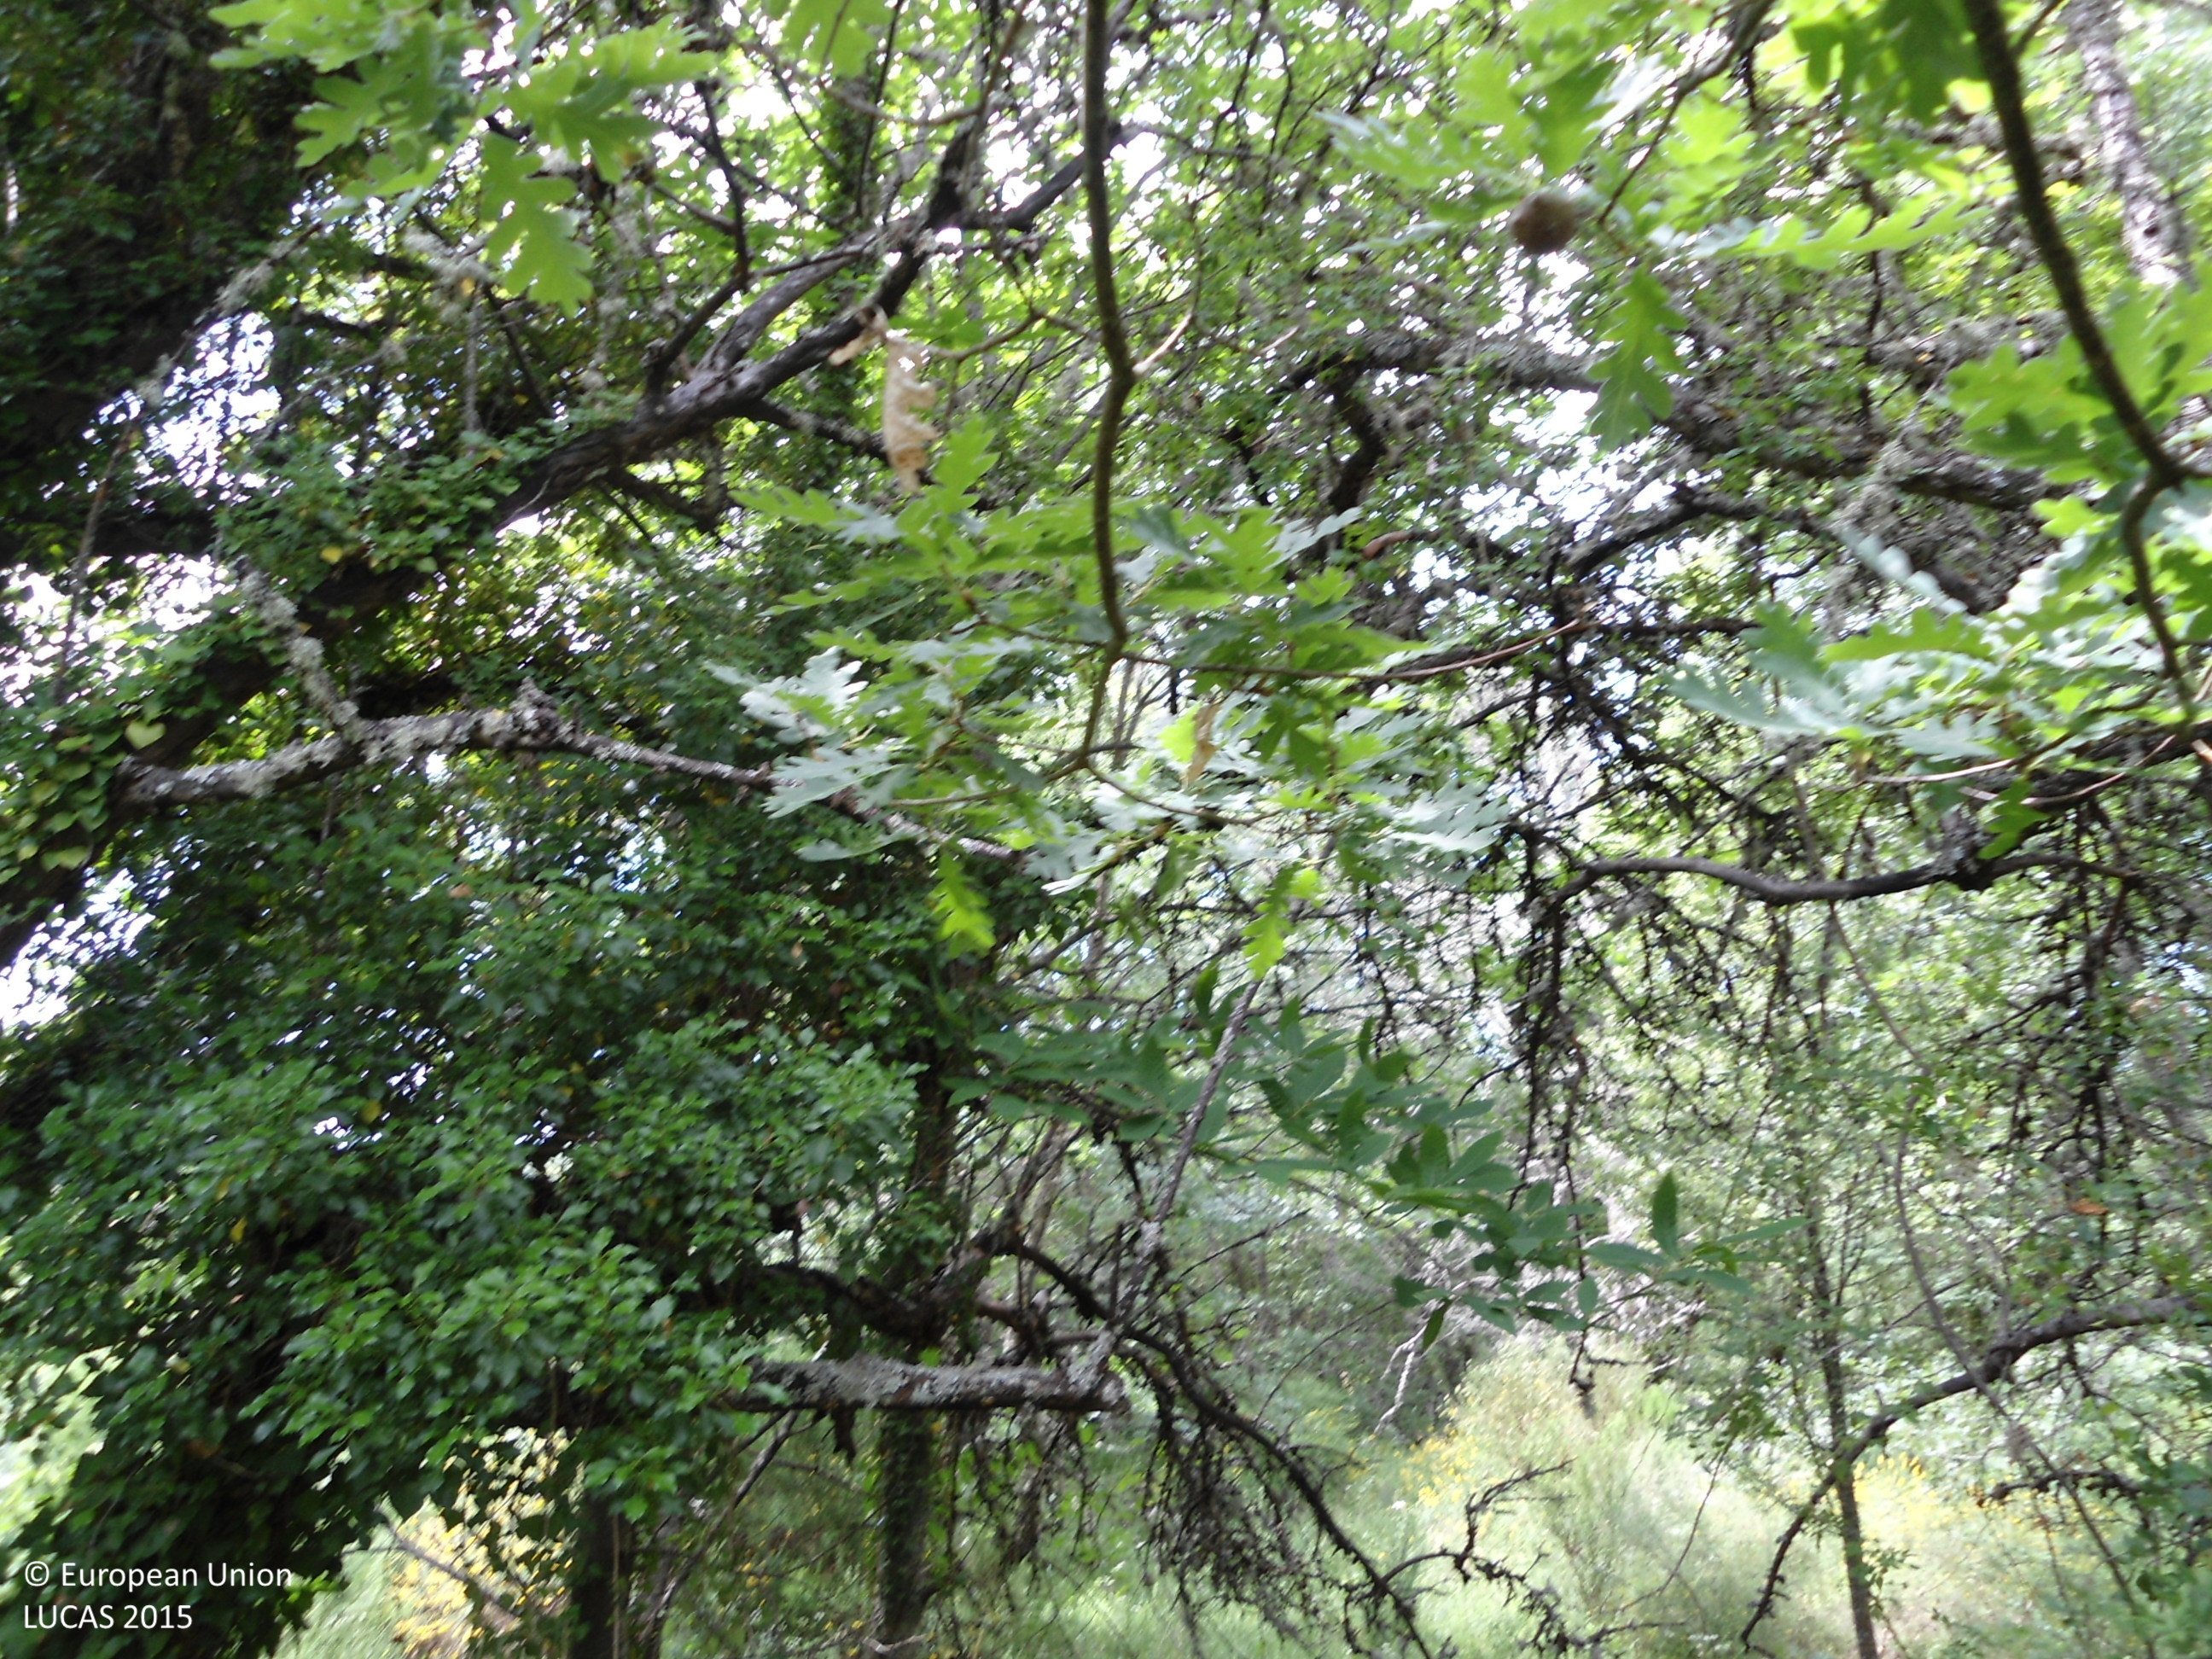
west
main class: Woodland
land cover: Broadleaved woodland
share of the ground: > 75 %
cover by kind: broadleaved forest trees 90 %, shrubs 10 %
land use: Forestry
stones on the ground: < 10 %
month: June
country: ES
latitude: 42.0978
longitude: -6.6187
